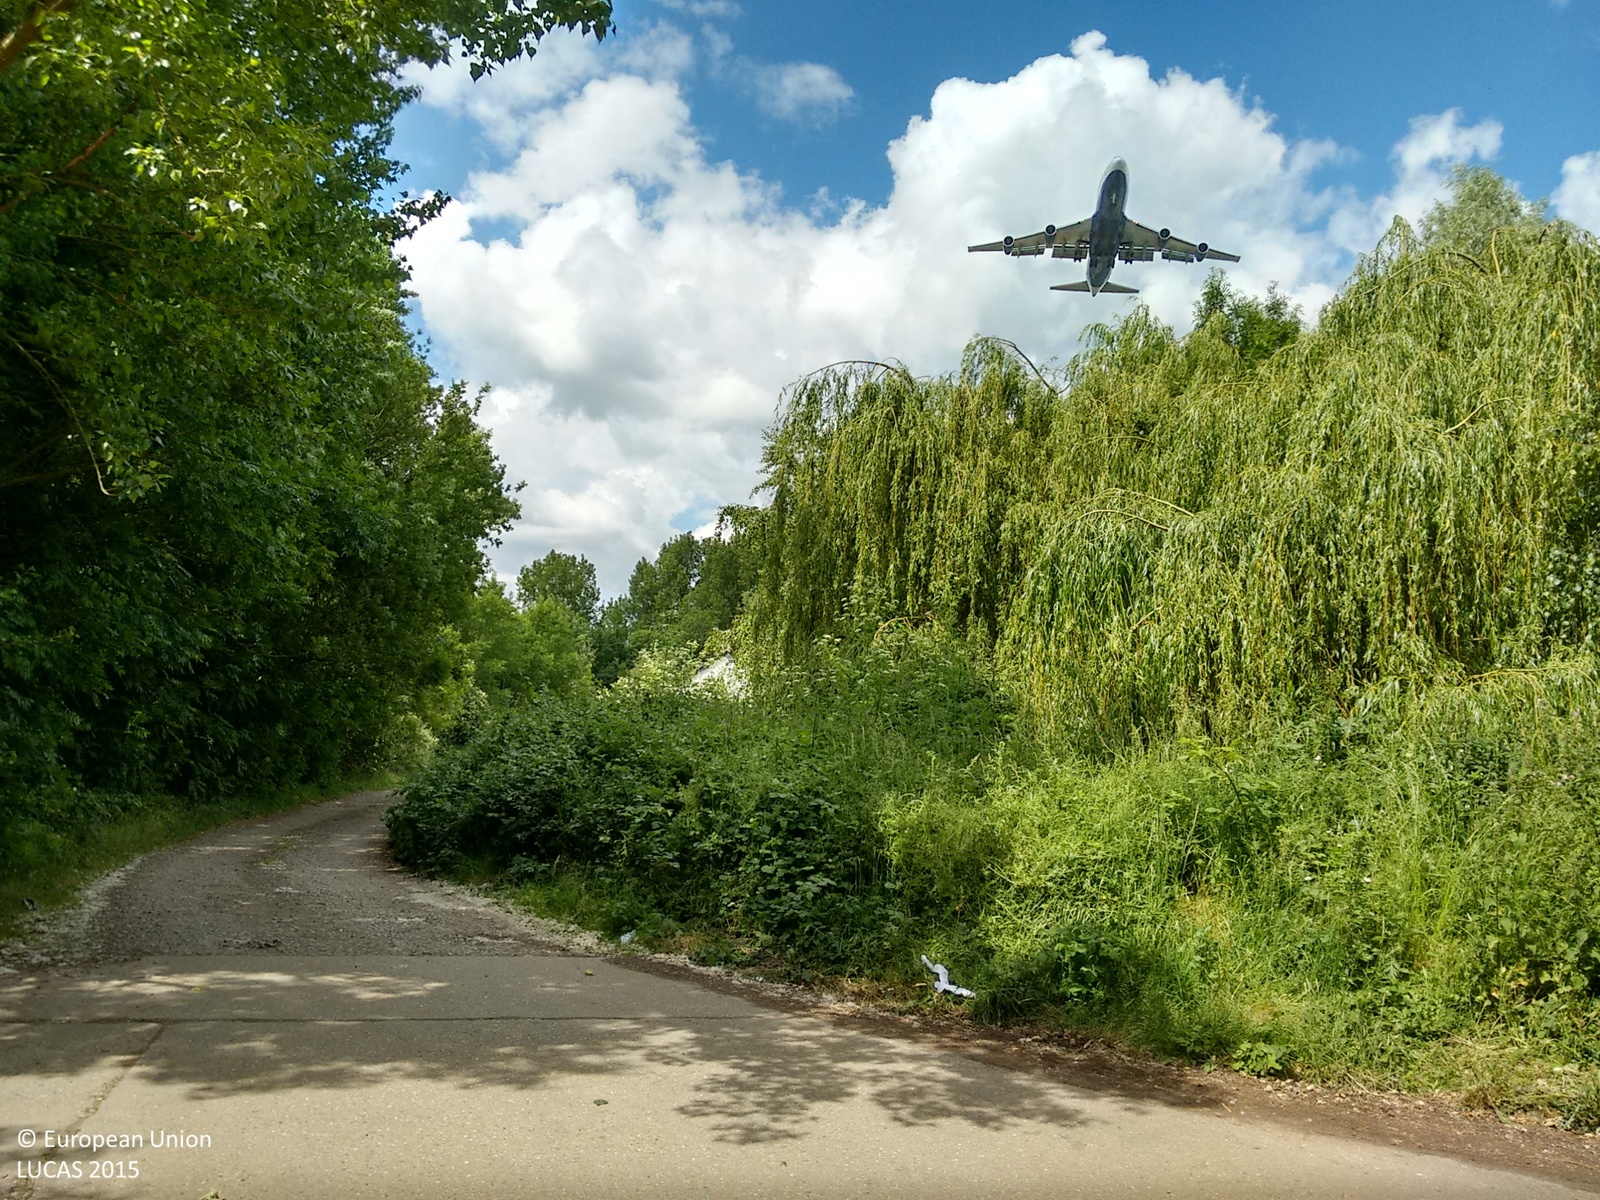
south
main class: Grassland
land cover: Grassland with sparse tree/shrub cover
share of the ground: > 75 %
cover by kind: herbaceous plants 95 %, broadleaved forest trees 5 %
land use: Semi-natural and natural areas not in use
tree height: < 5 m
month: June
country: GB
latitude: 51.4748
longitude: -0.5055
